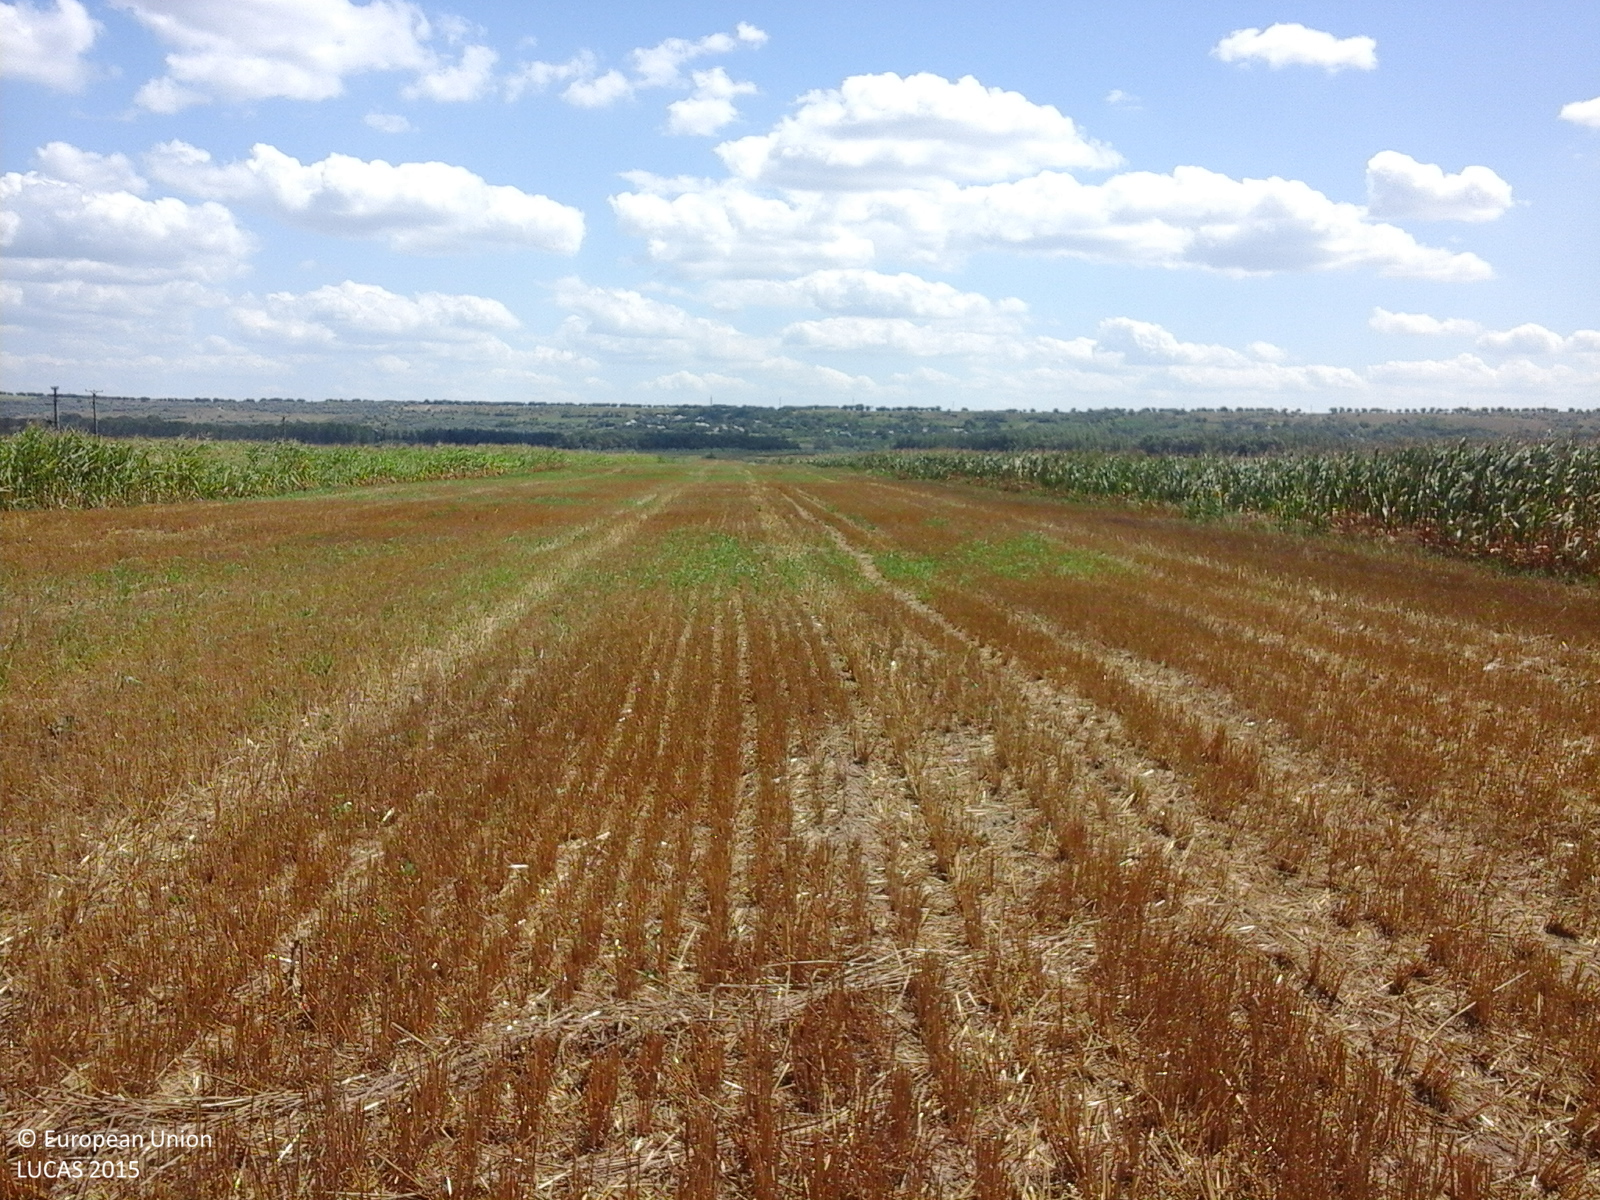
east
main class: Cropland
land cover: Common wheat
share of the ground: 50 - 75 %
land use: Agriculture (excluding fallow land and kitchen gardens)
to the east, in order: Common wheat
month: July
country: RO
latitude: 46.4268
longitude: 28.2343
